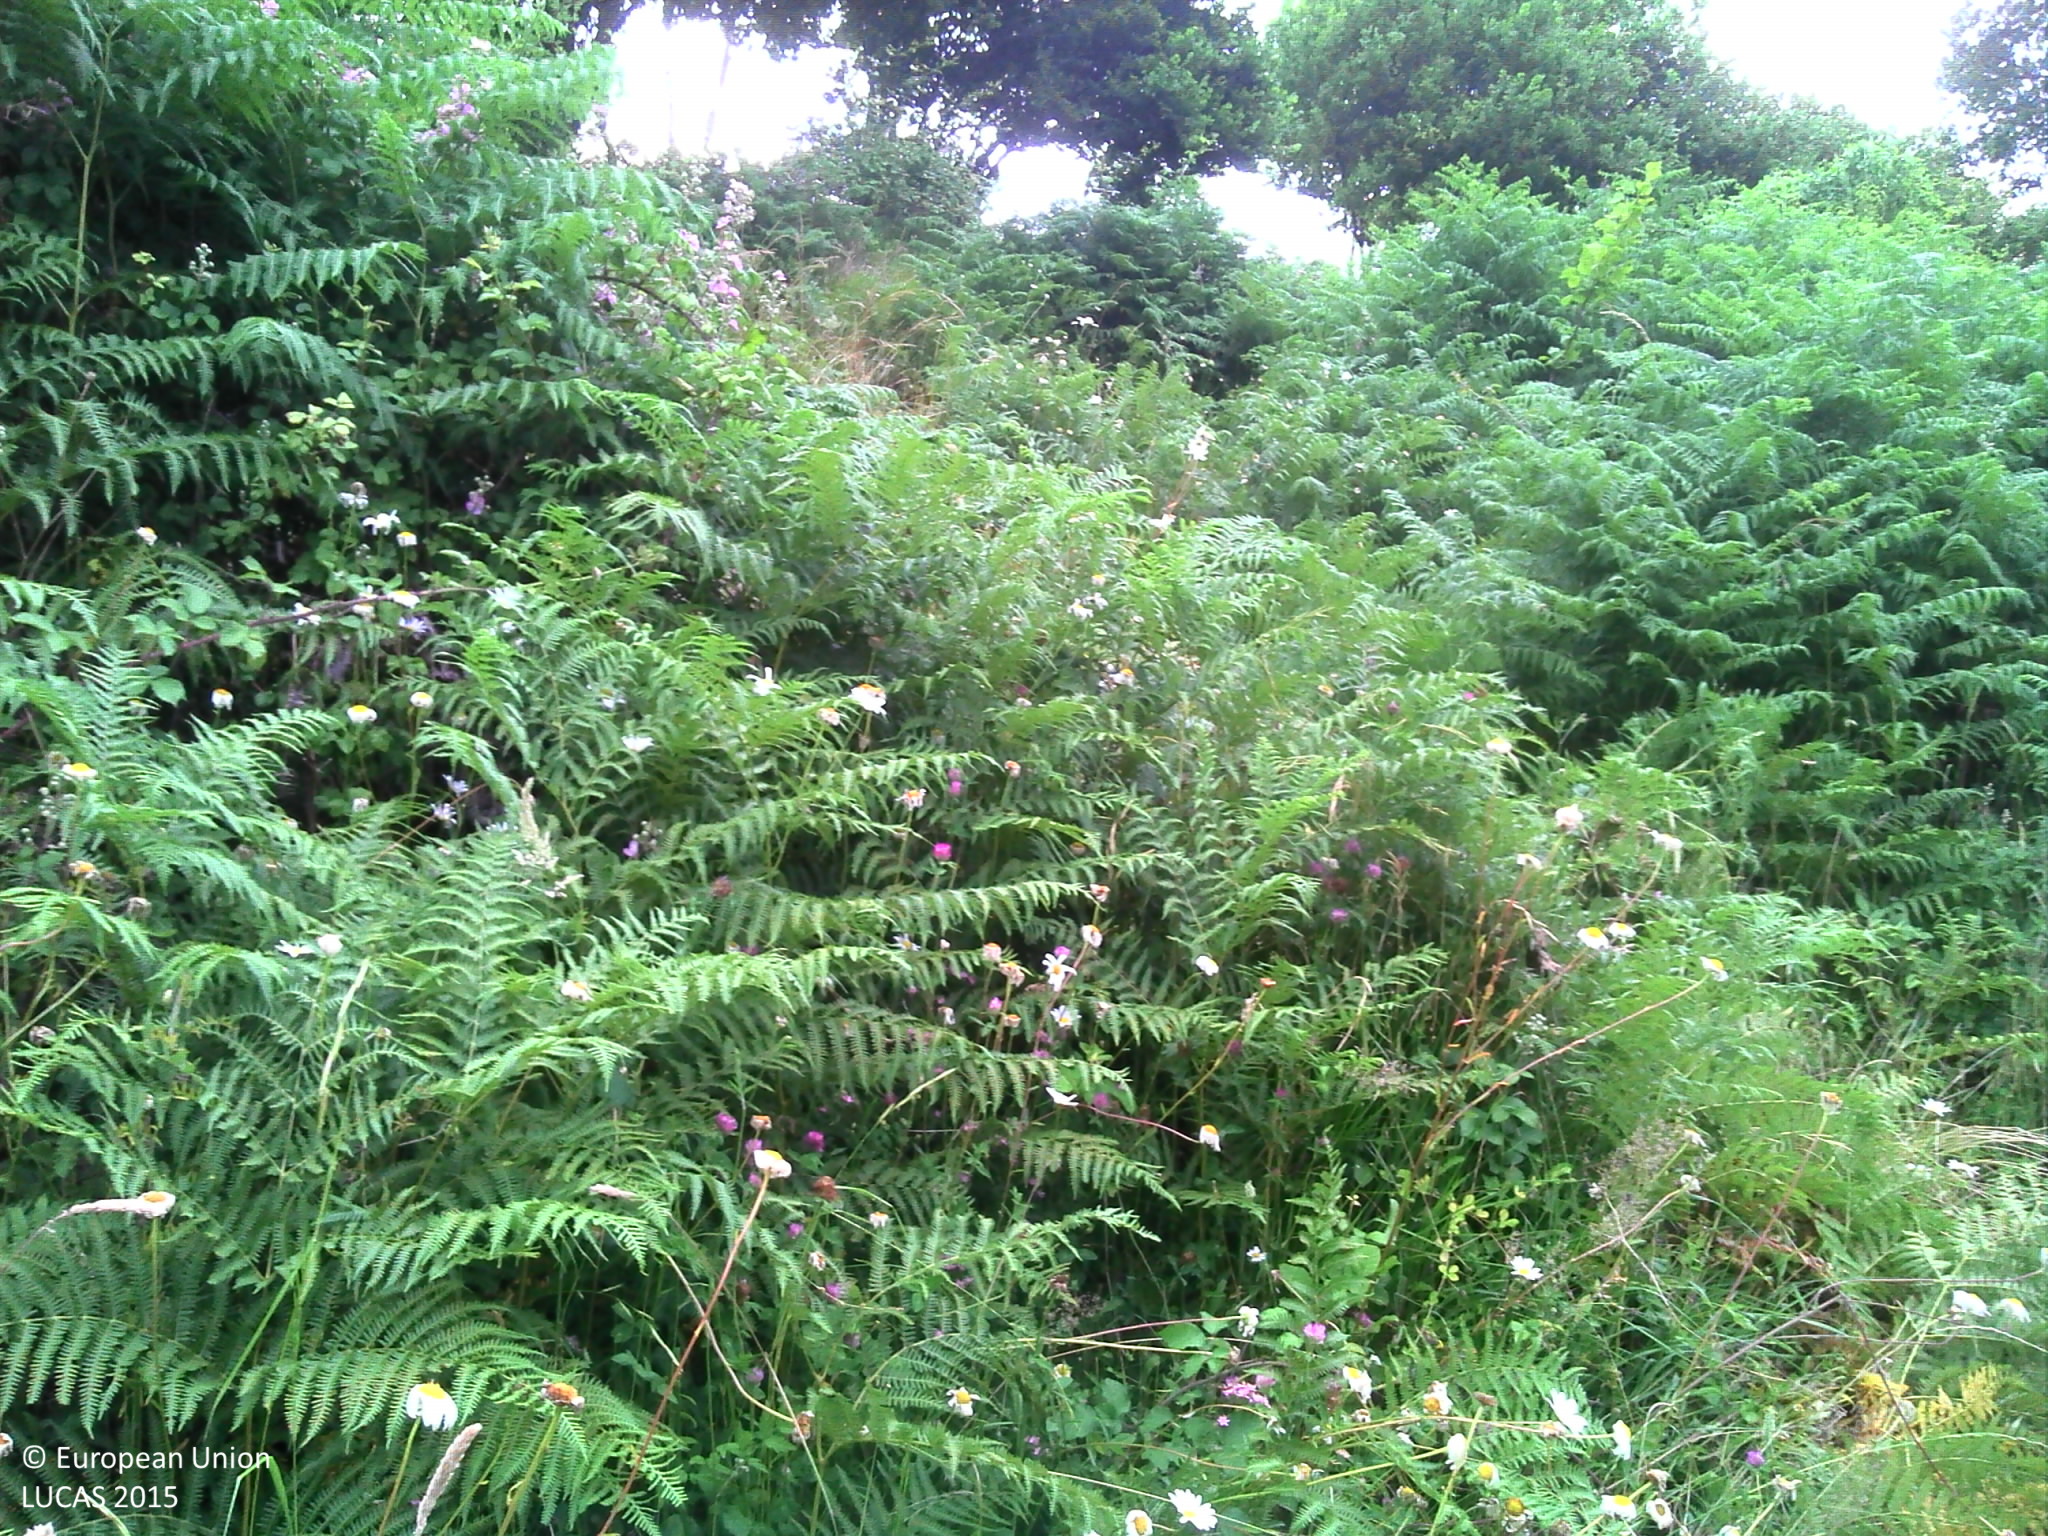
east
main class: Grassland
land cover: Spontaneously vegetated surfaces
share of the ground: > 75 %
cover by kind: herbaceous plants 95 %, shrubs 5 %
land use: Agriculture (excluding fallow land and kitchen gardens)
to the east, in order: Spontaneously vegetated surfaces; Fences; Broadleaved woodland; Grassland without tree/shrub cover; Fences; Managed hedges; Grass margins; Paved roads, cycling and walking lanes; Grass margins; Broadleaved woodland; Tracks; Fences; Apple fruit
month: July
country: FR
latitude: 48.9701
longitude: 0.0660
